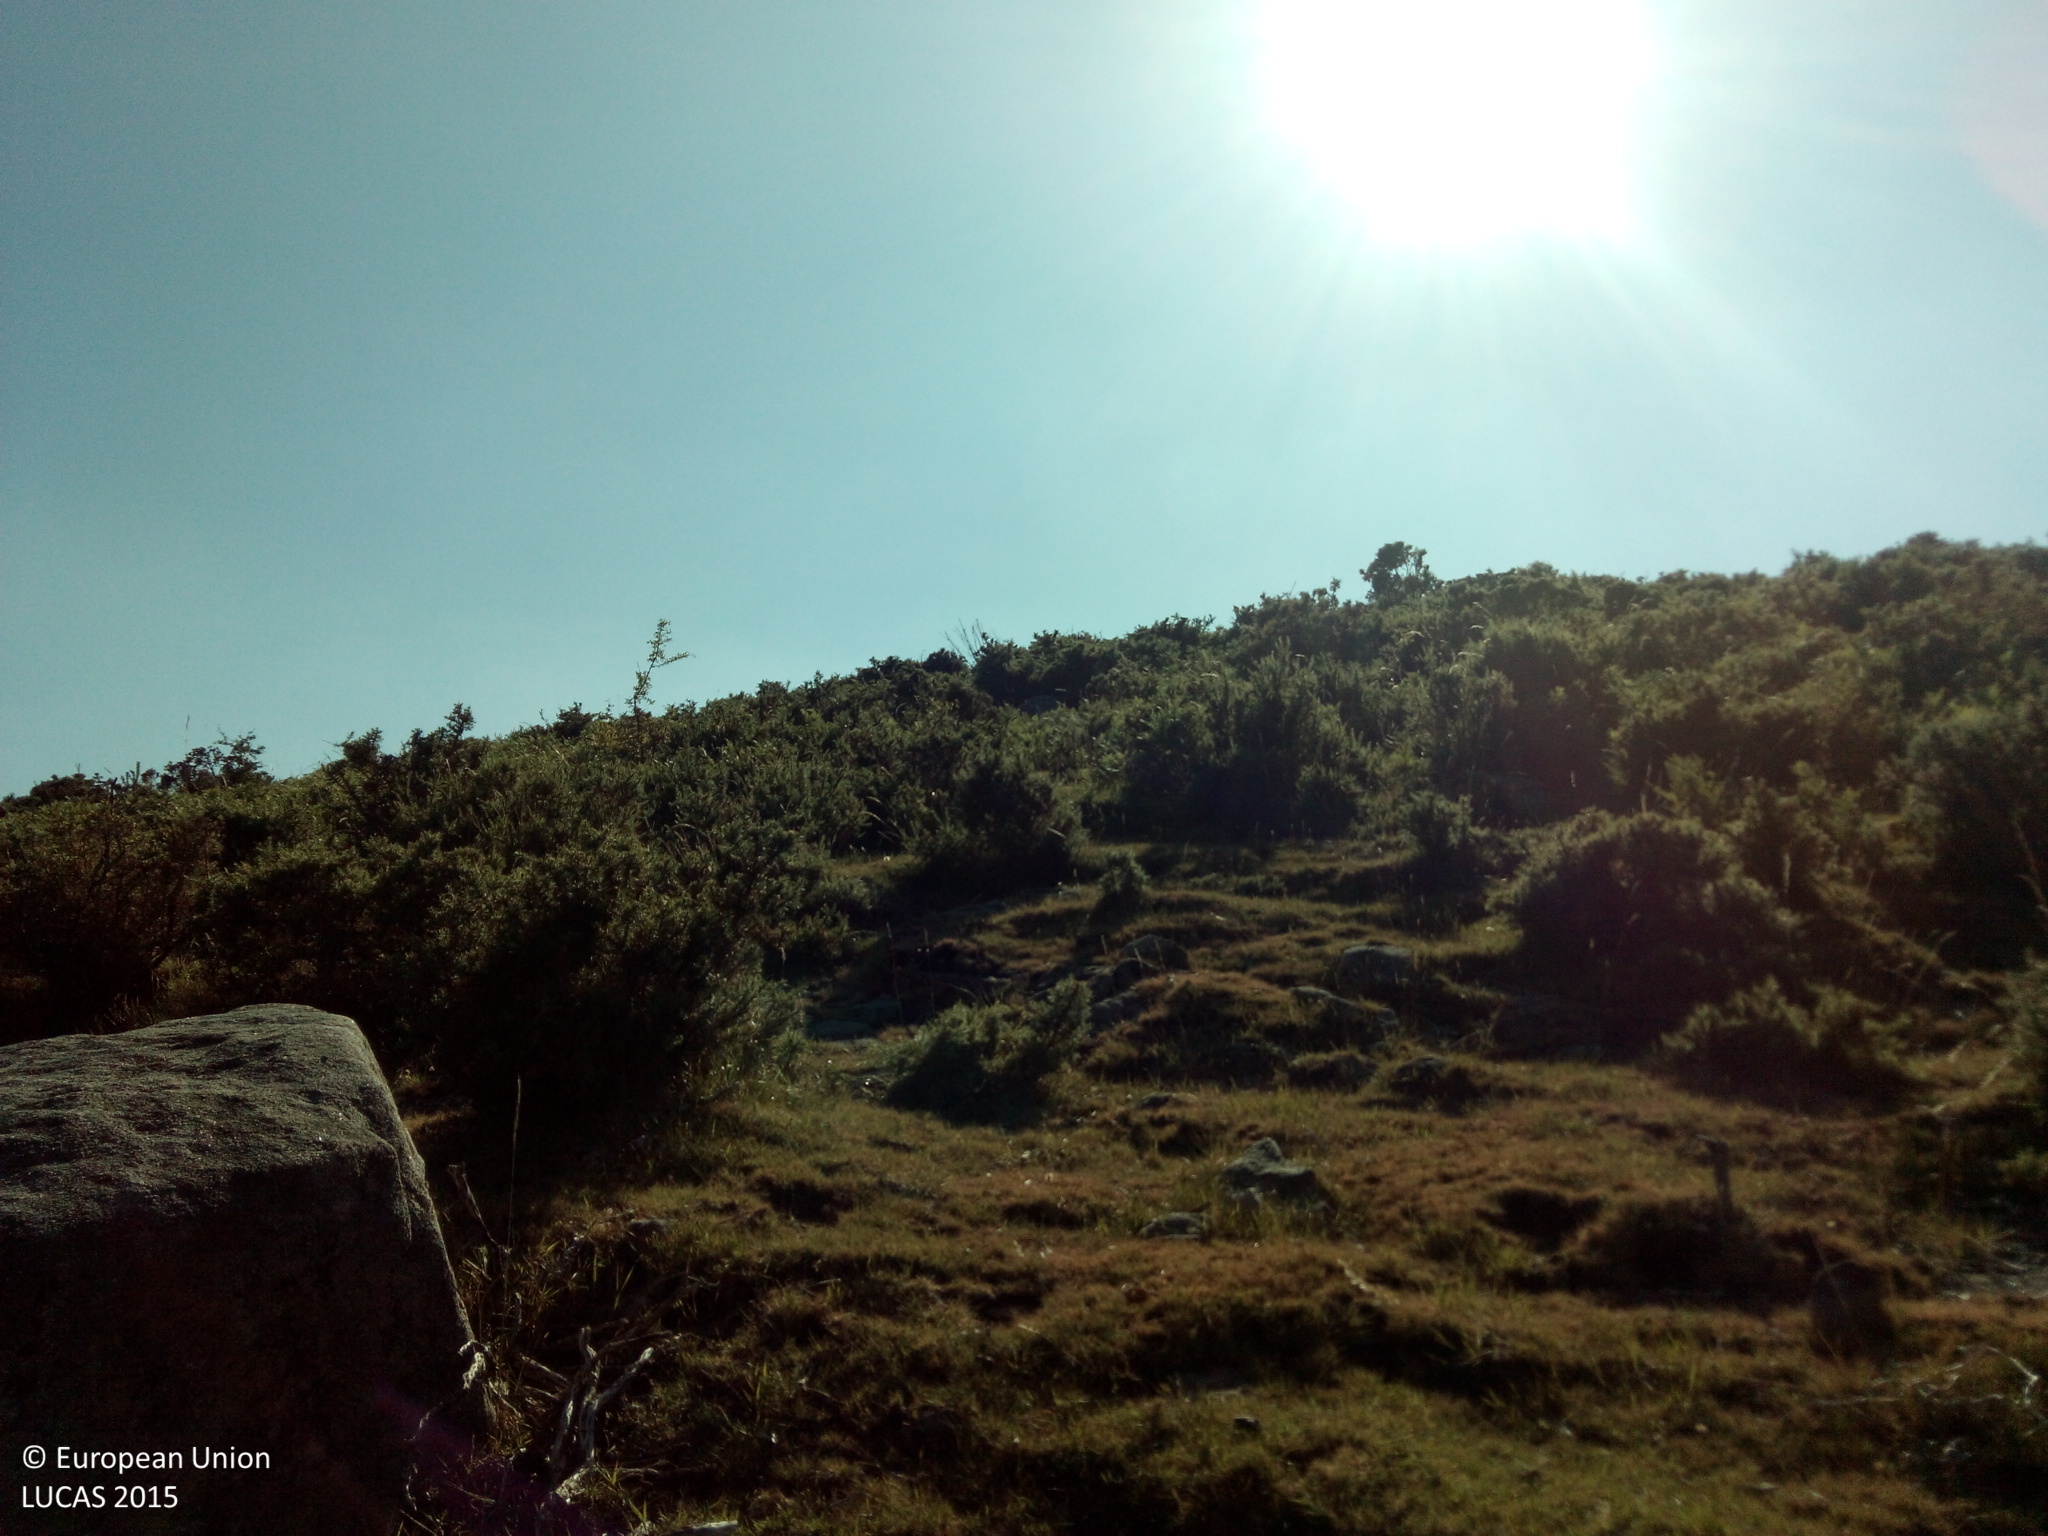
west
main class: Shrubland
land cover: Shrubland with sparse tree cover
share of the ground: > 75 %
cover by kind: shrubs 95 %, broadleaved forest trees 5 %
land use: Semi-natural and natural areas not in use
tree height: > 5 m
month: June
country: ES
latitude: 42.3440
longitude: -8.3600
